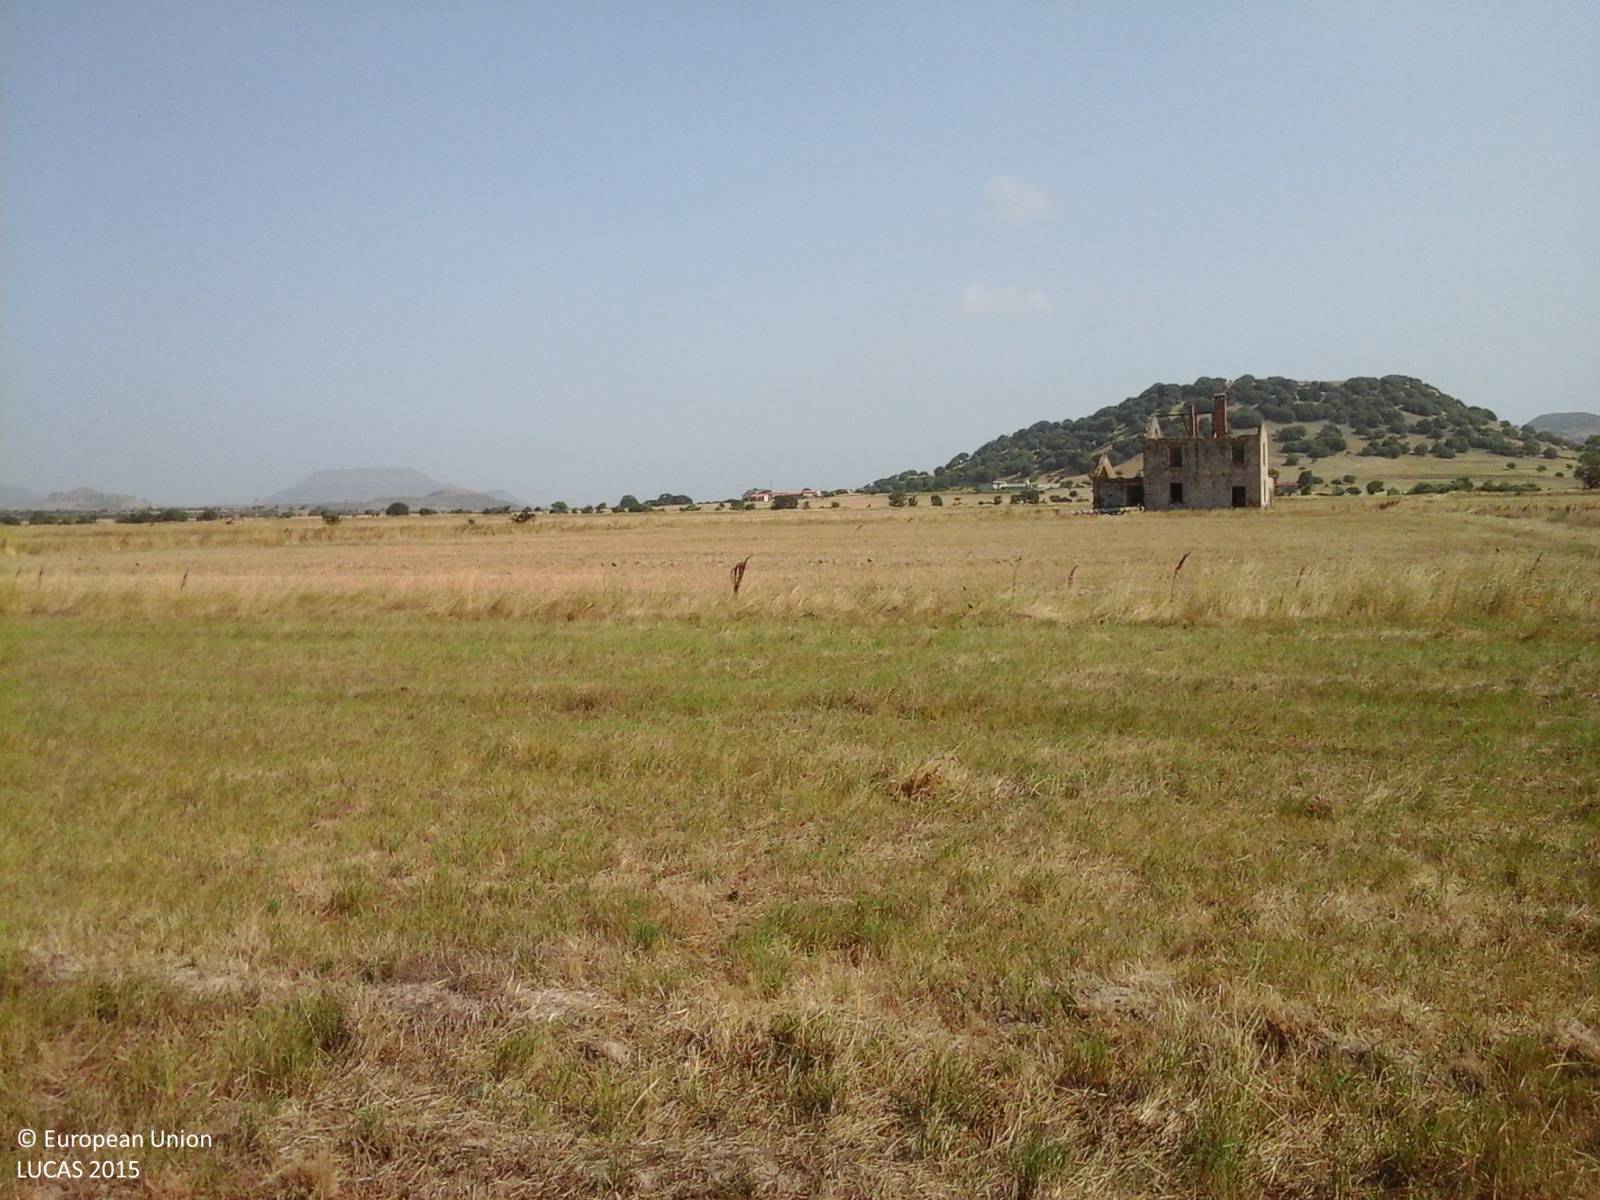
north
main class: Grassland
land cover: Grassland without tree/shrub cover
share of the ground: < 10 %
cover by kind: herbaceous plants 100 %
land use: Agriculture (excluding fallow land and kitchen gardens)
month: July
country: IT
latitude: 40.4593
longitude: 8.8149
